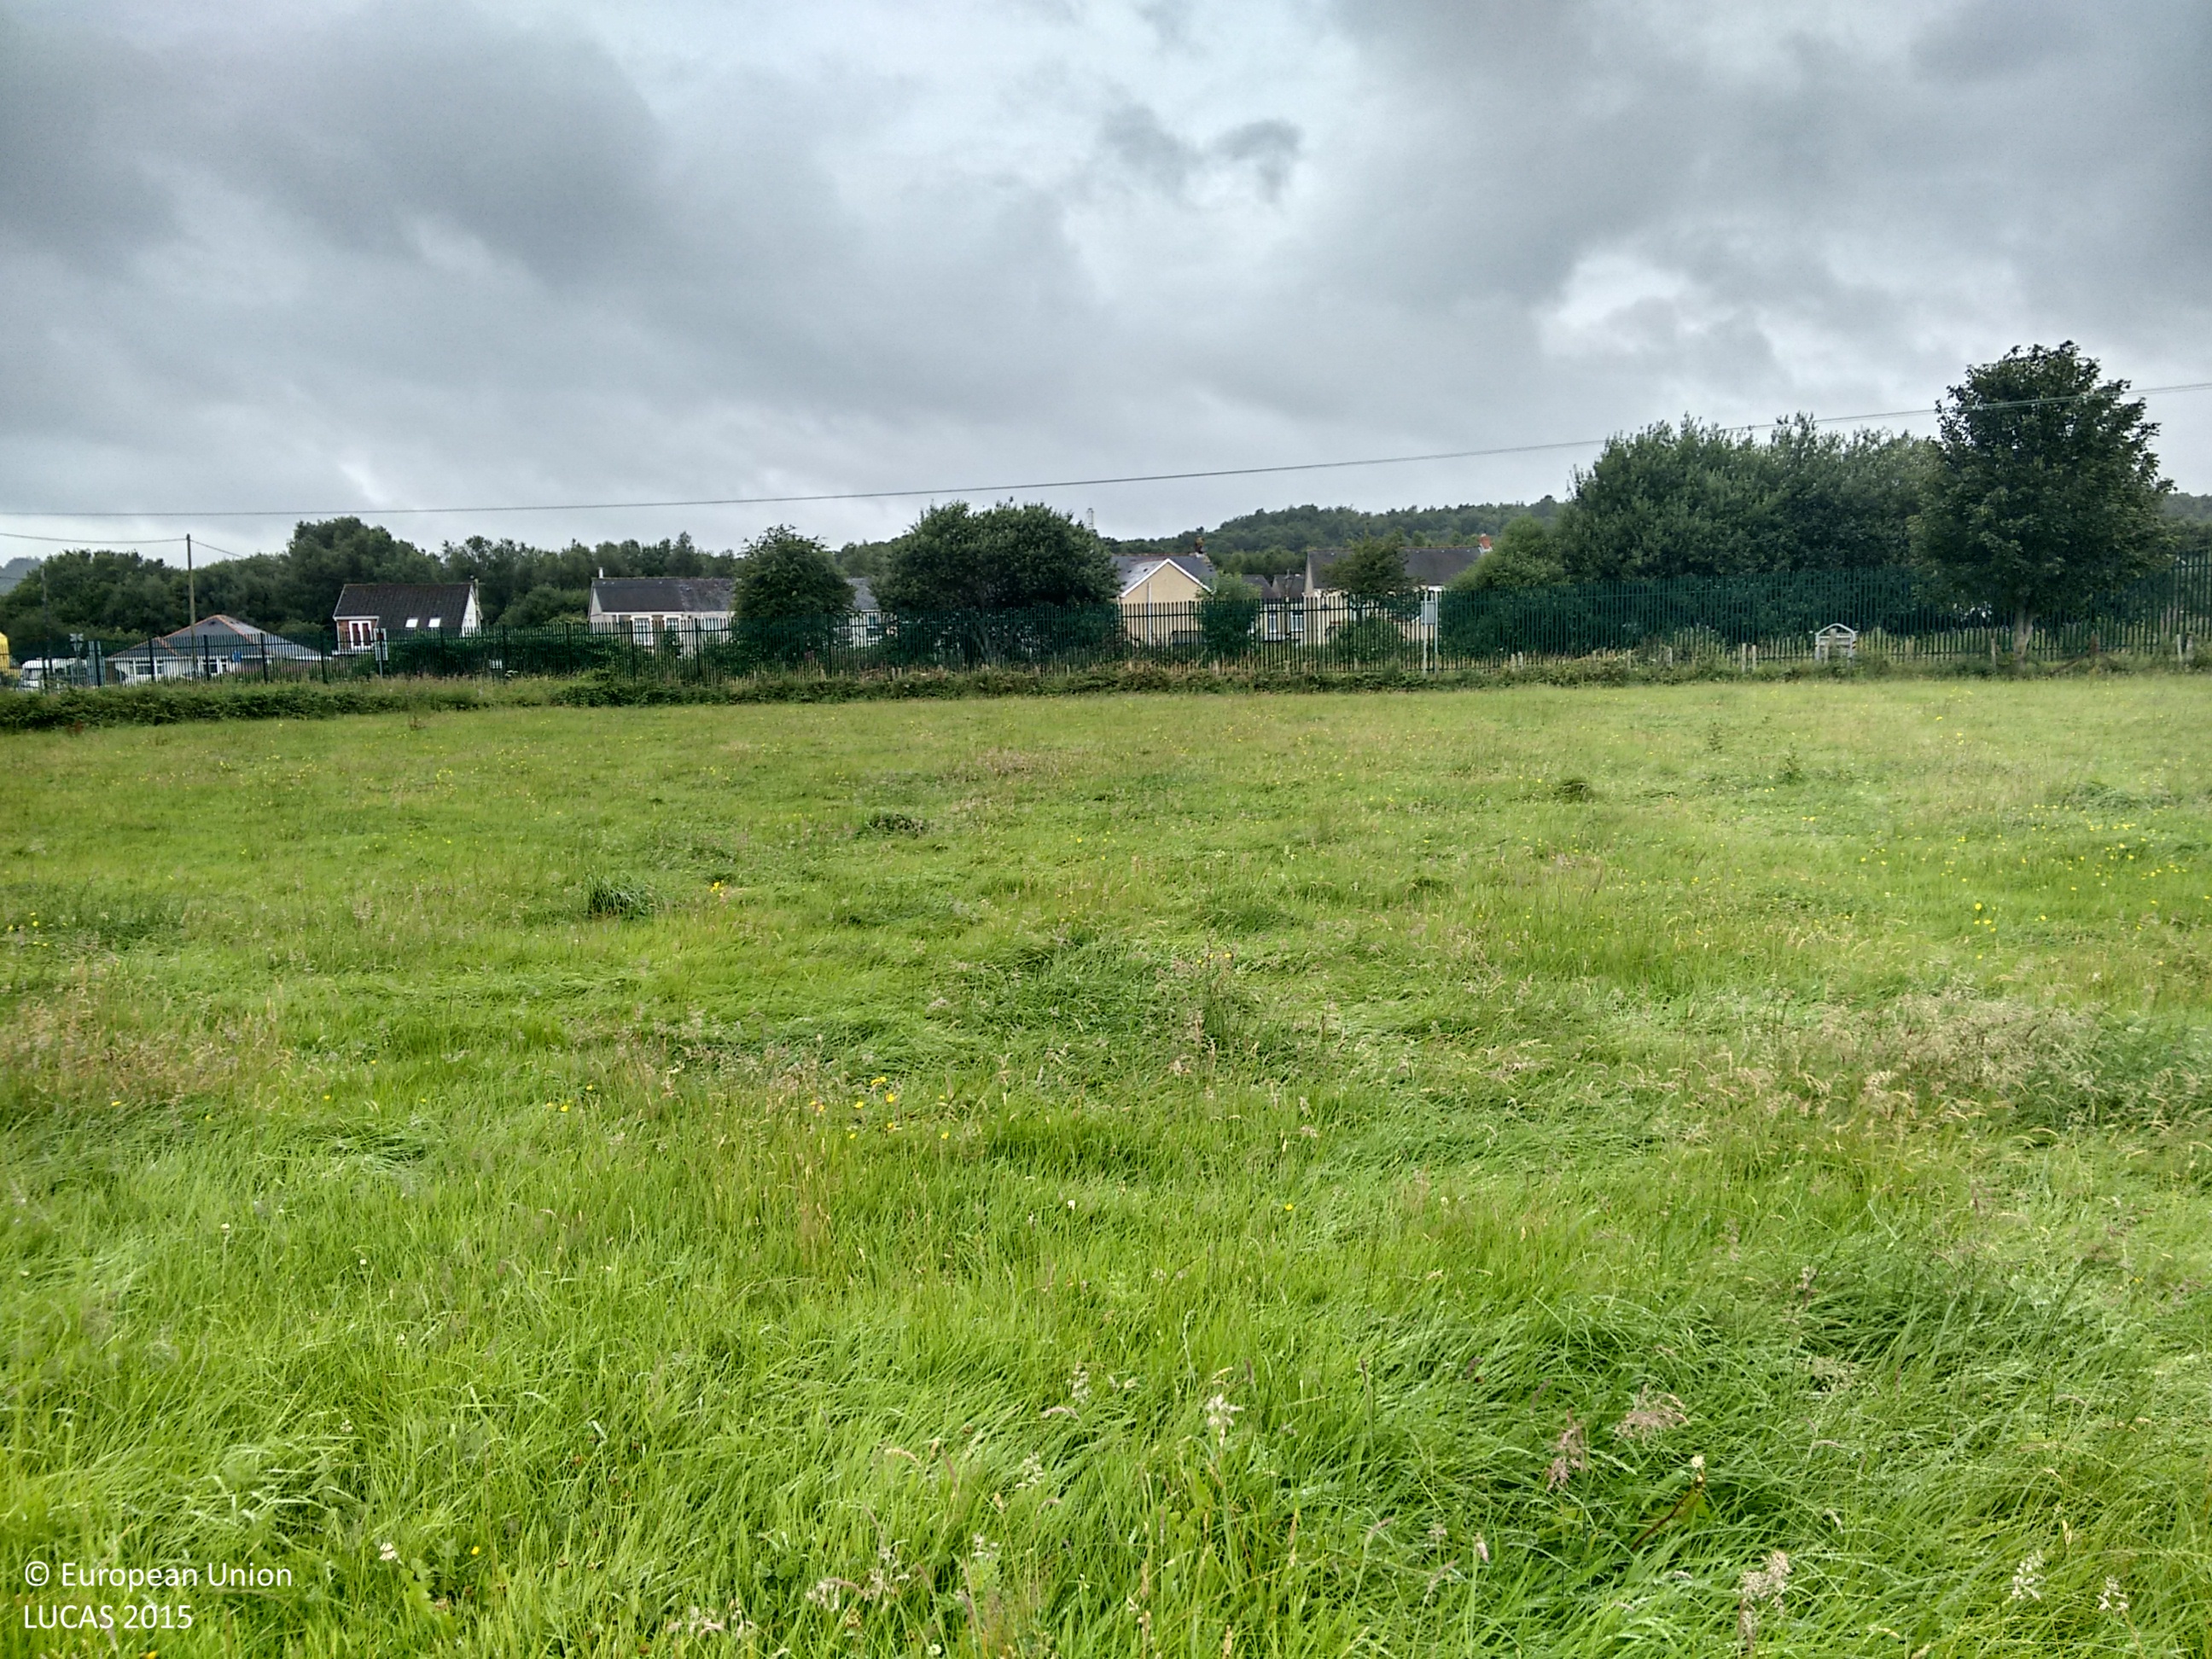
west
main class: Grassland
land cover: Grassland without tree/shrub cover
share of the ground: > 75 %
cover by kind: herbaceous plants 100 %
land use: Agriculture (excluding fallow land and kitchen gardens)
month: July
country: GB
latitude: 51.7803
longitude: -3.9950
